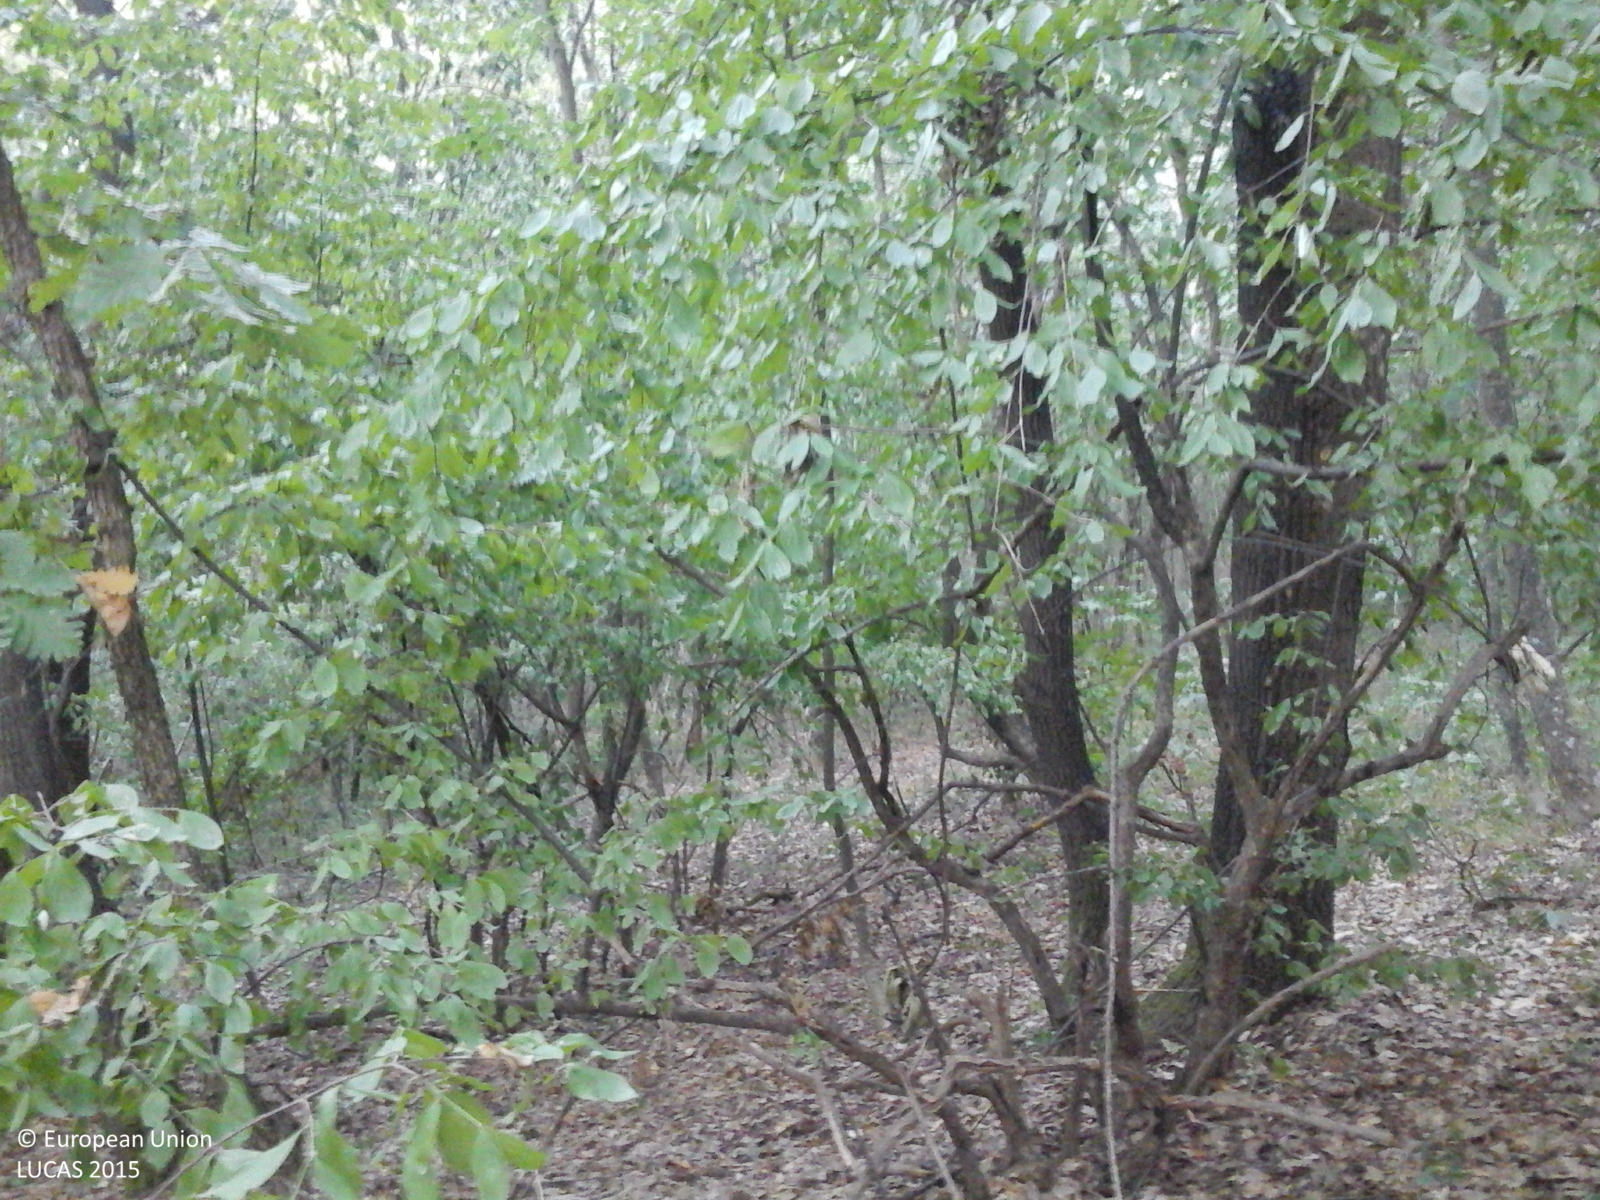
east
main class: Woodland
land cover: Broadleaved woodland
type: acidophilous oak and oak-birch forest
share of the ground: > 75 %
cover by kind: broadleaved forest trees 100 %
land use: Forestry
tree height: > 5 m
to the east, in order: Broadleaved woodland; Tracks; Broadleaved woodland
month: August
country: RO
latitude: 44.5643
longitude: 23.1810
